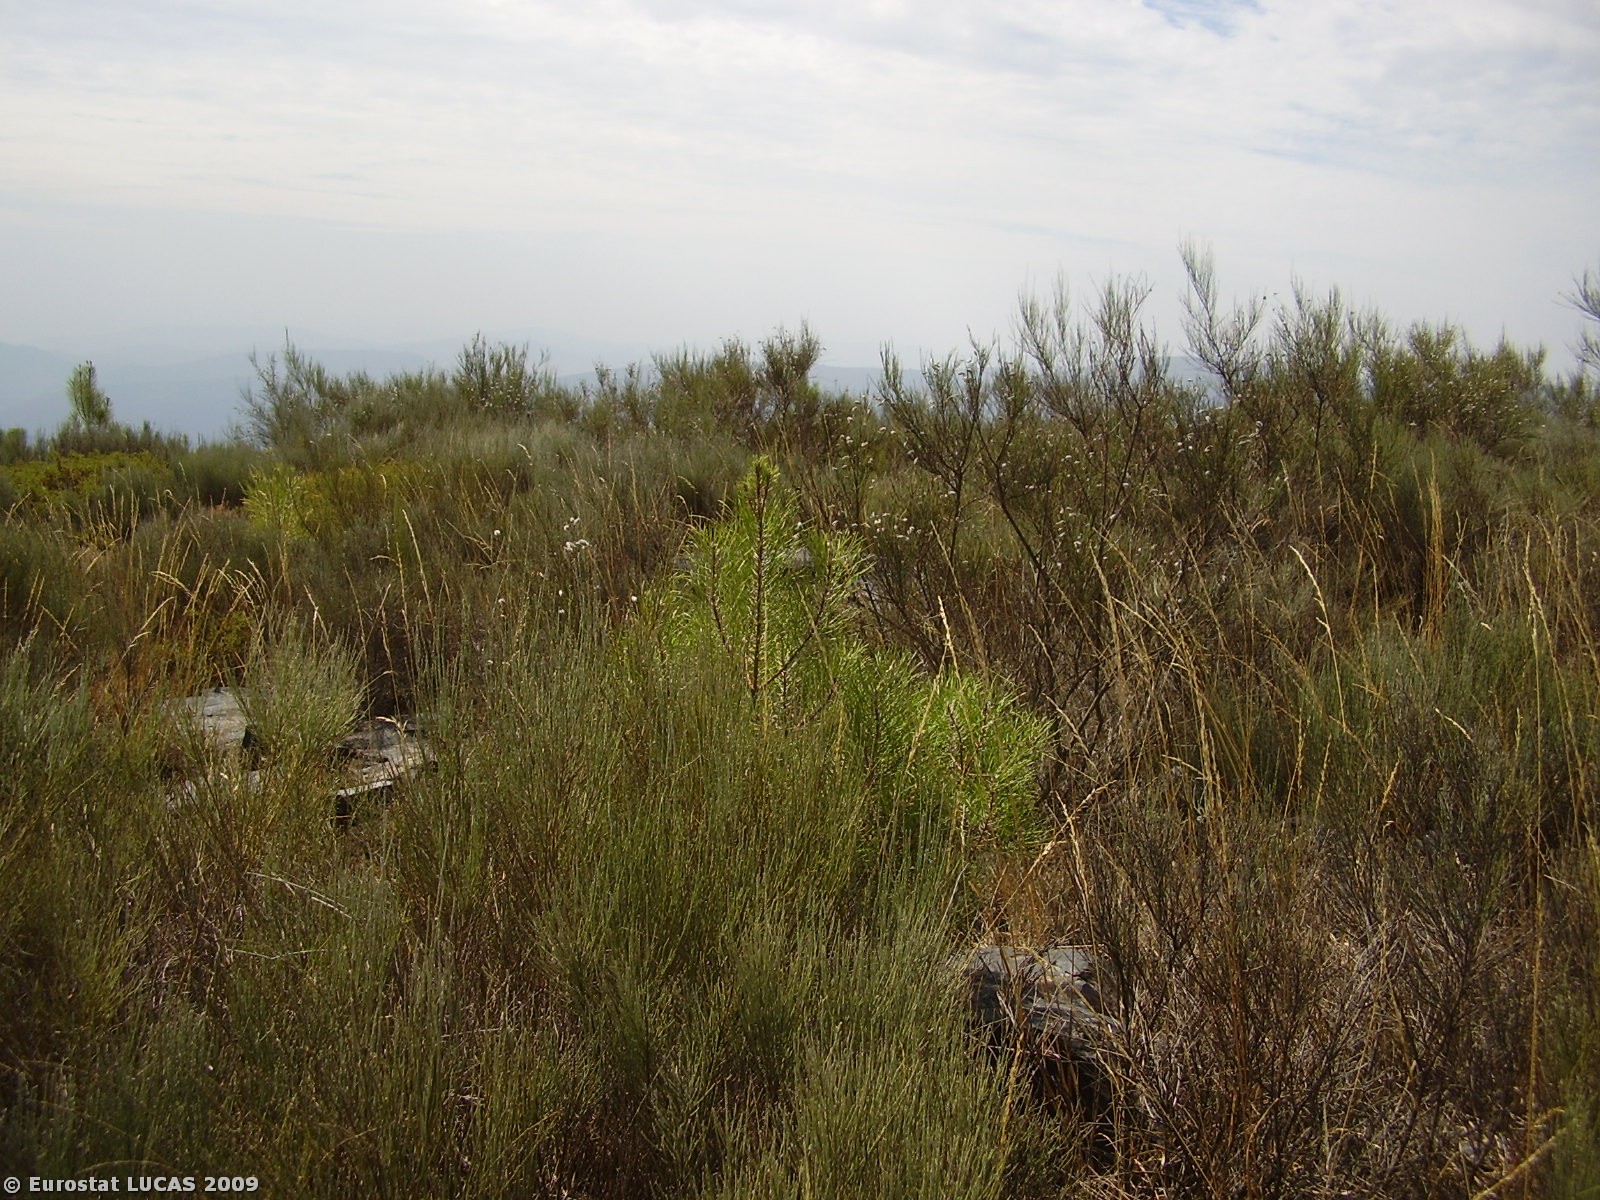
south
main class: Shrubland
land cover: Shrubland with sparse tree cover
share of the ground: > 75 %
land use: Fallow land
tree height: > 5 m
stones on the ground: 25 - 50 %
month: September
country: PT
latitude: 41.1720
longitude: -6.9751
